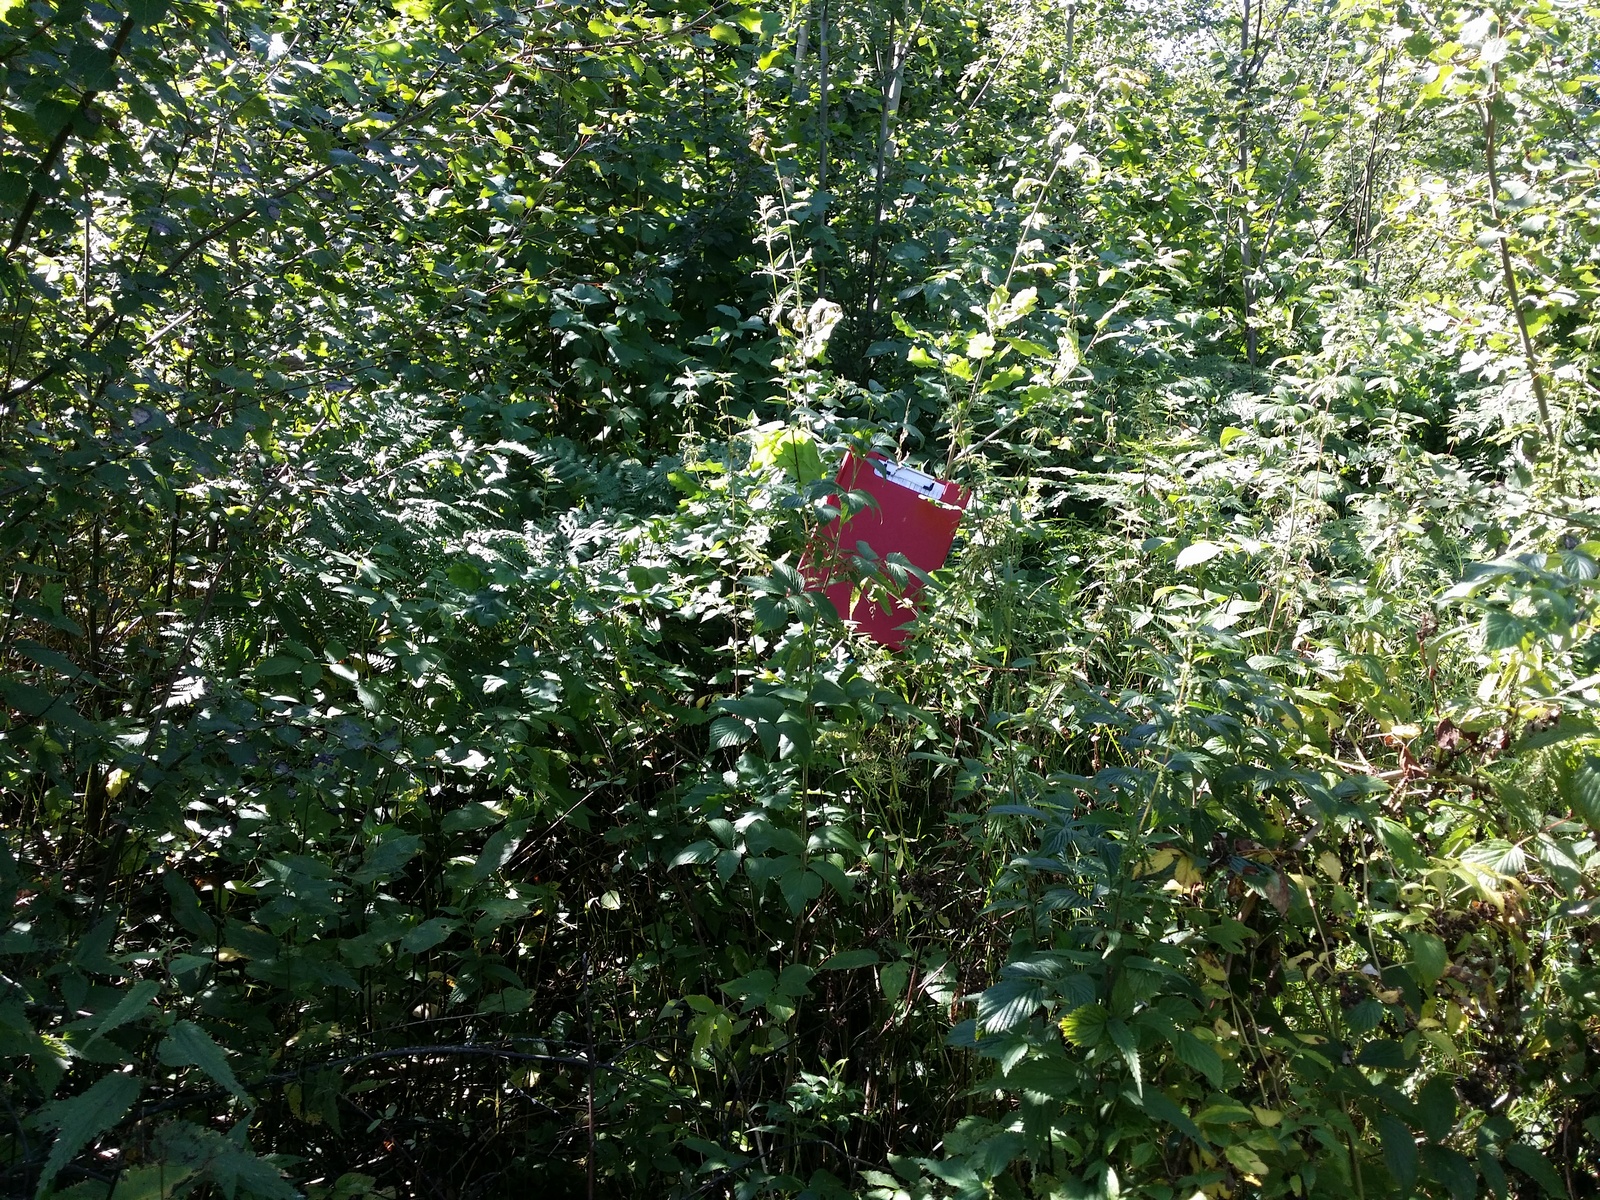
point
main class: Woodland
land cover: Broadleaved woodland
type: non-riverine alder, birch or aspen forest
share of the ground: > 75 %
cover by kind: broadleaved forest trees 90 %, herbaceous plants 10 %
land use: Forestry
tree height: < 5 m
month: August
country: LV
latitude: 57.0515
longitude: 27.6734
